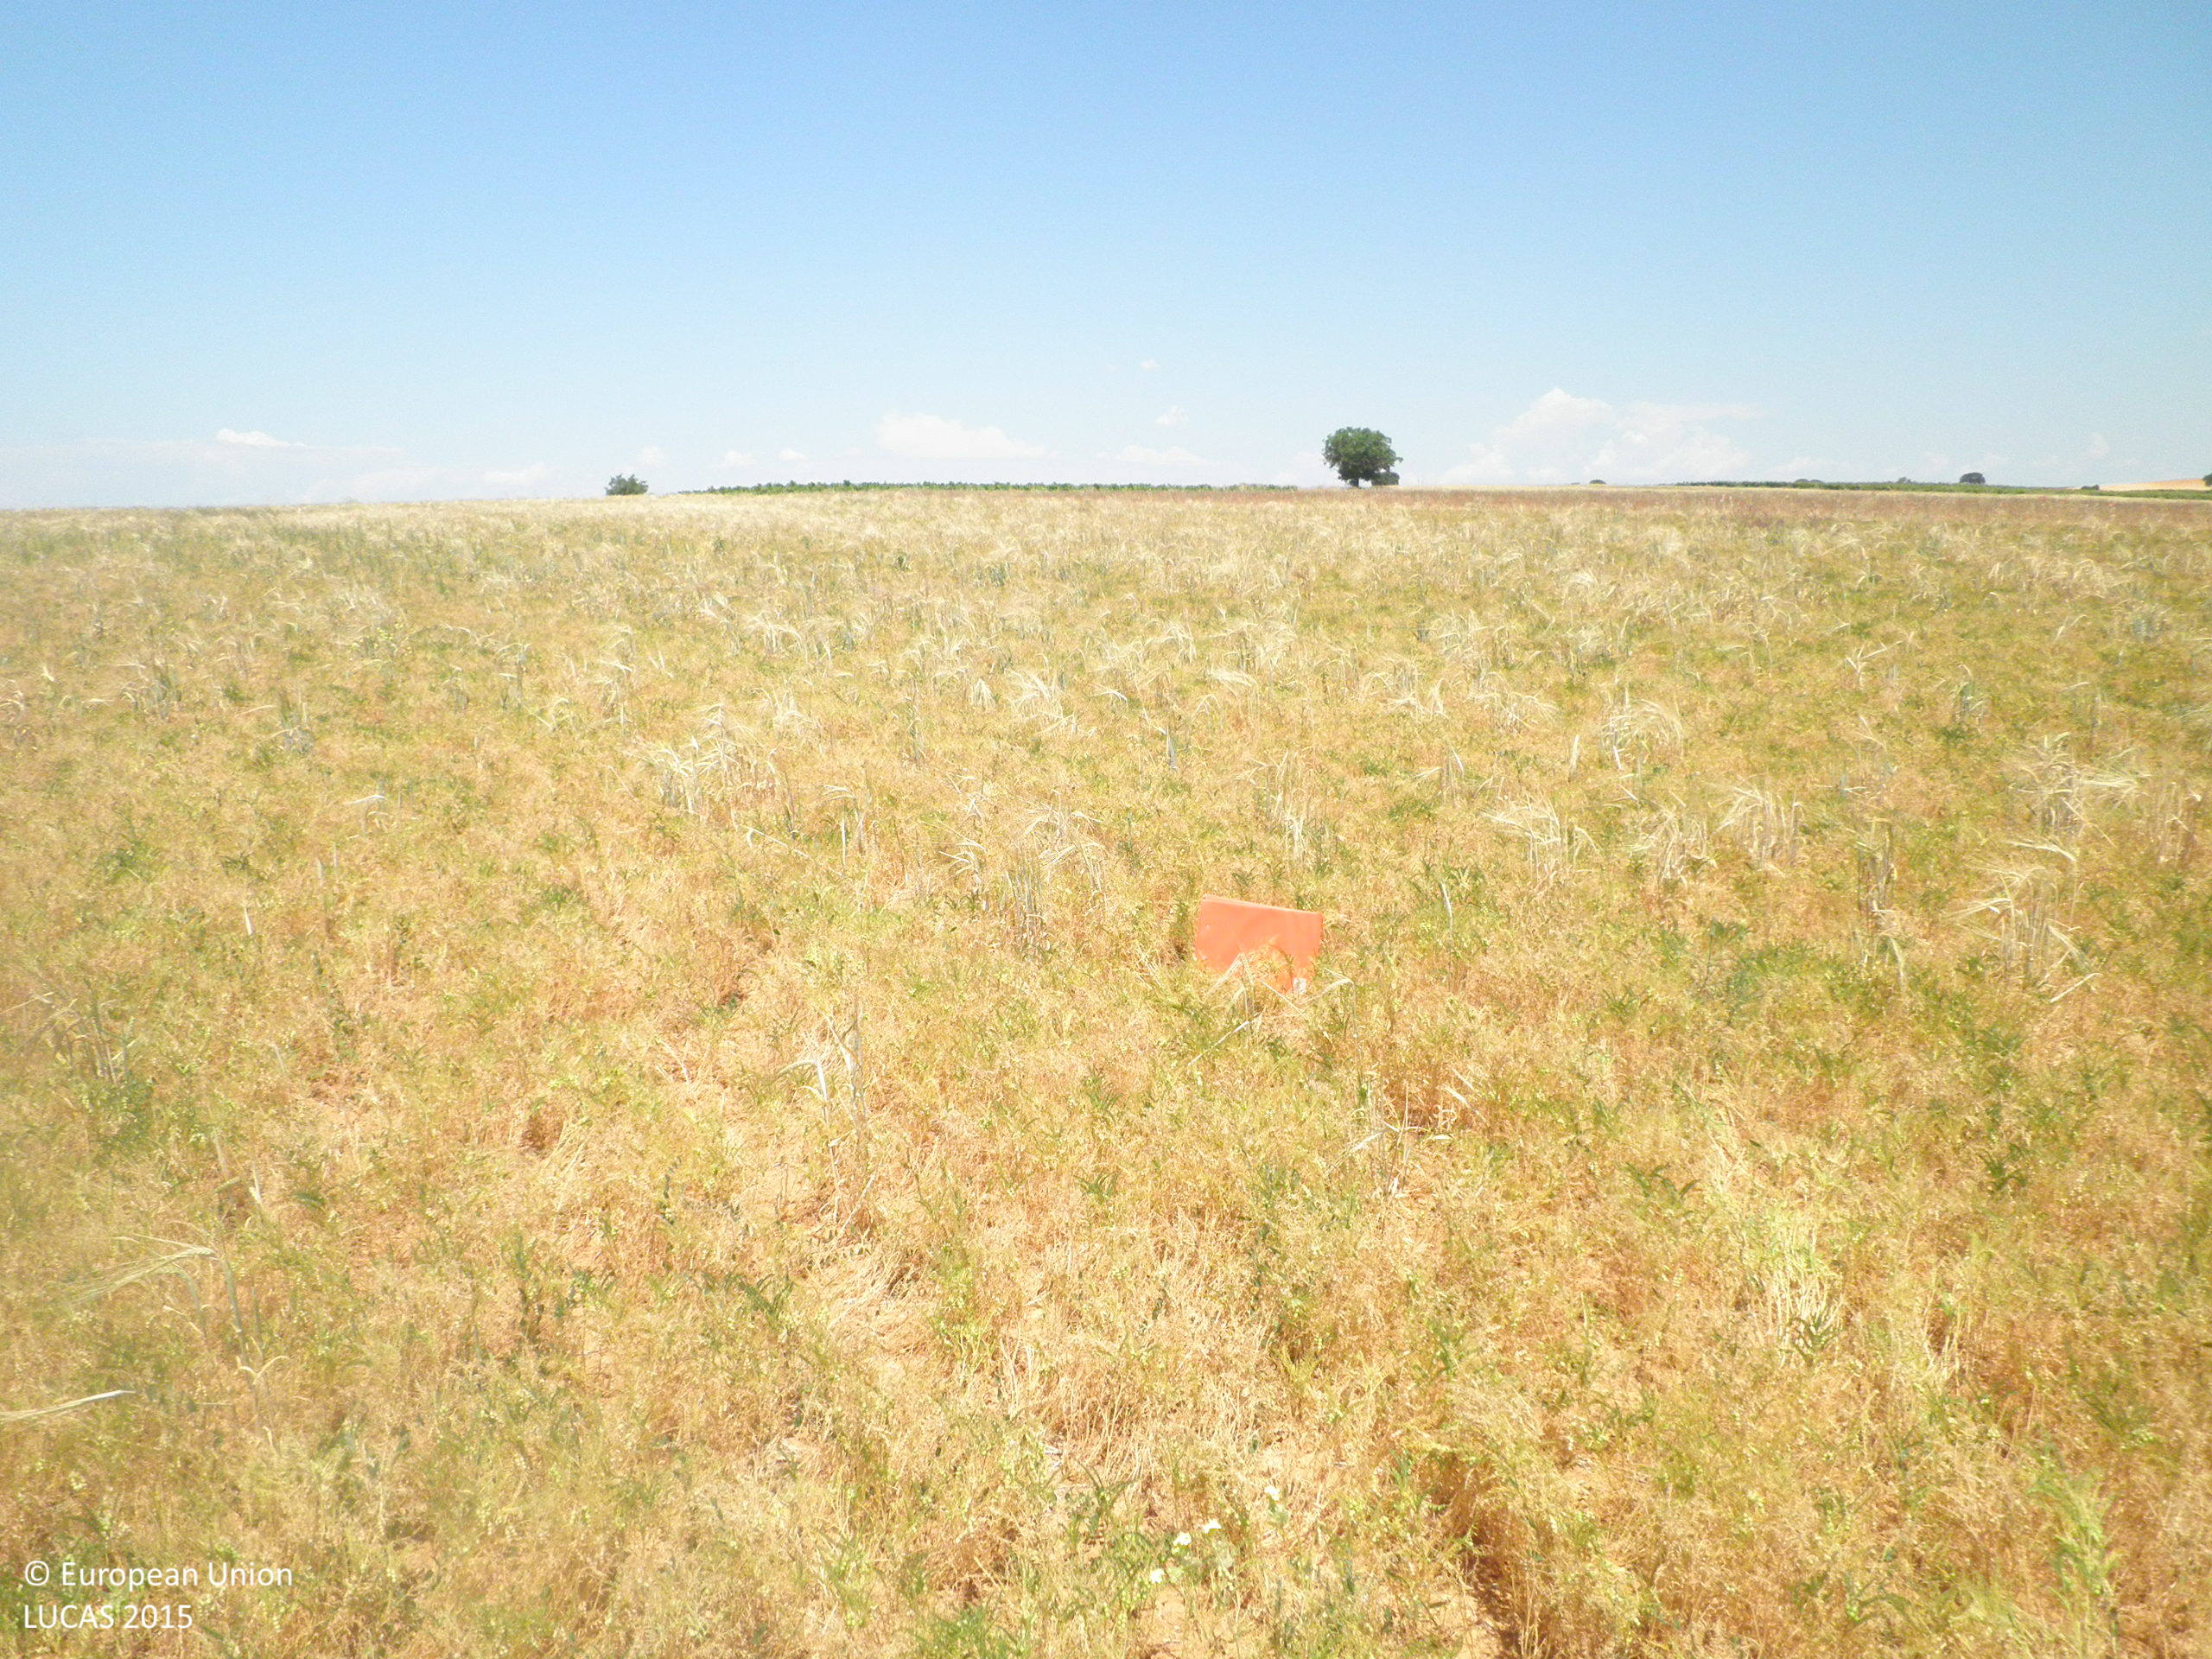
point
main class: Cropland
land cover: Dry pulses
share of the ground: 50 - 75 %
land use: Agriculture (excluding fallow land and kitchen gardens)
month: June
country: ES
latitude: 39.3207
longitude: -1.7537
